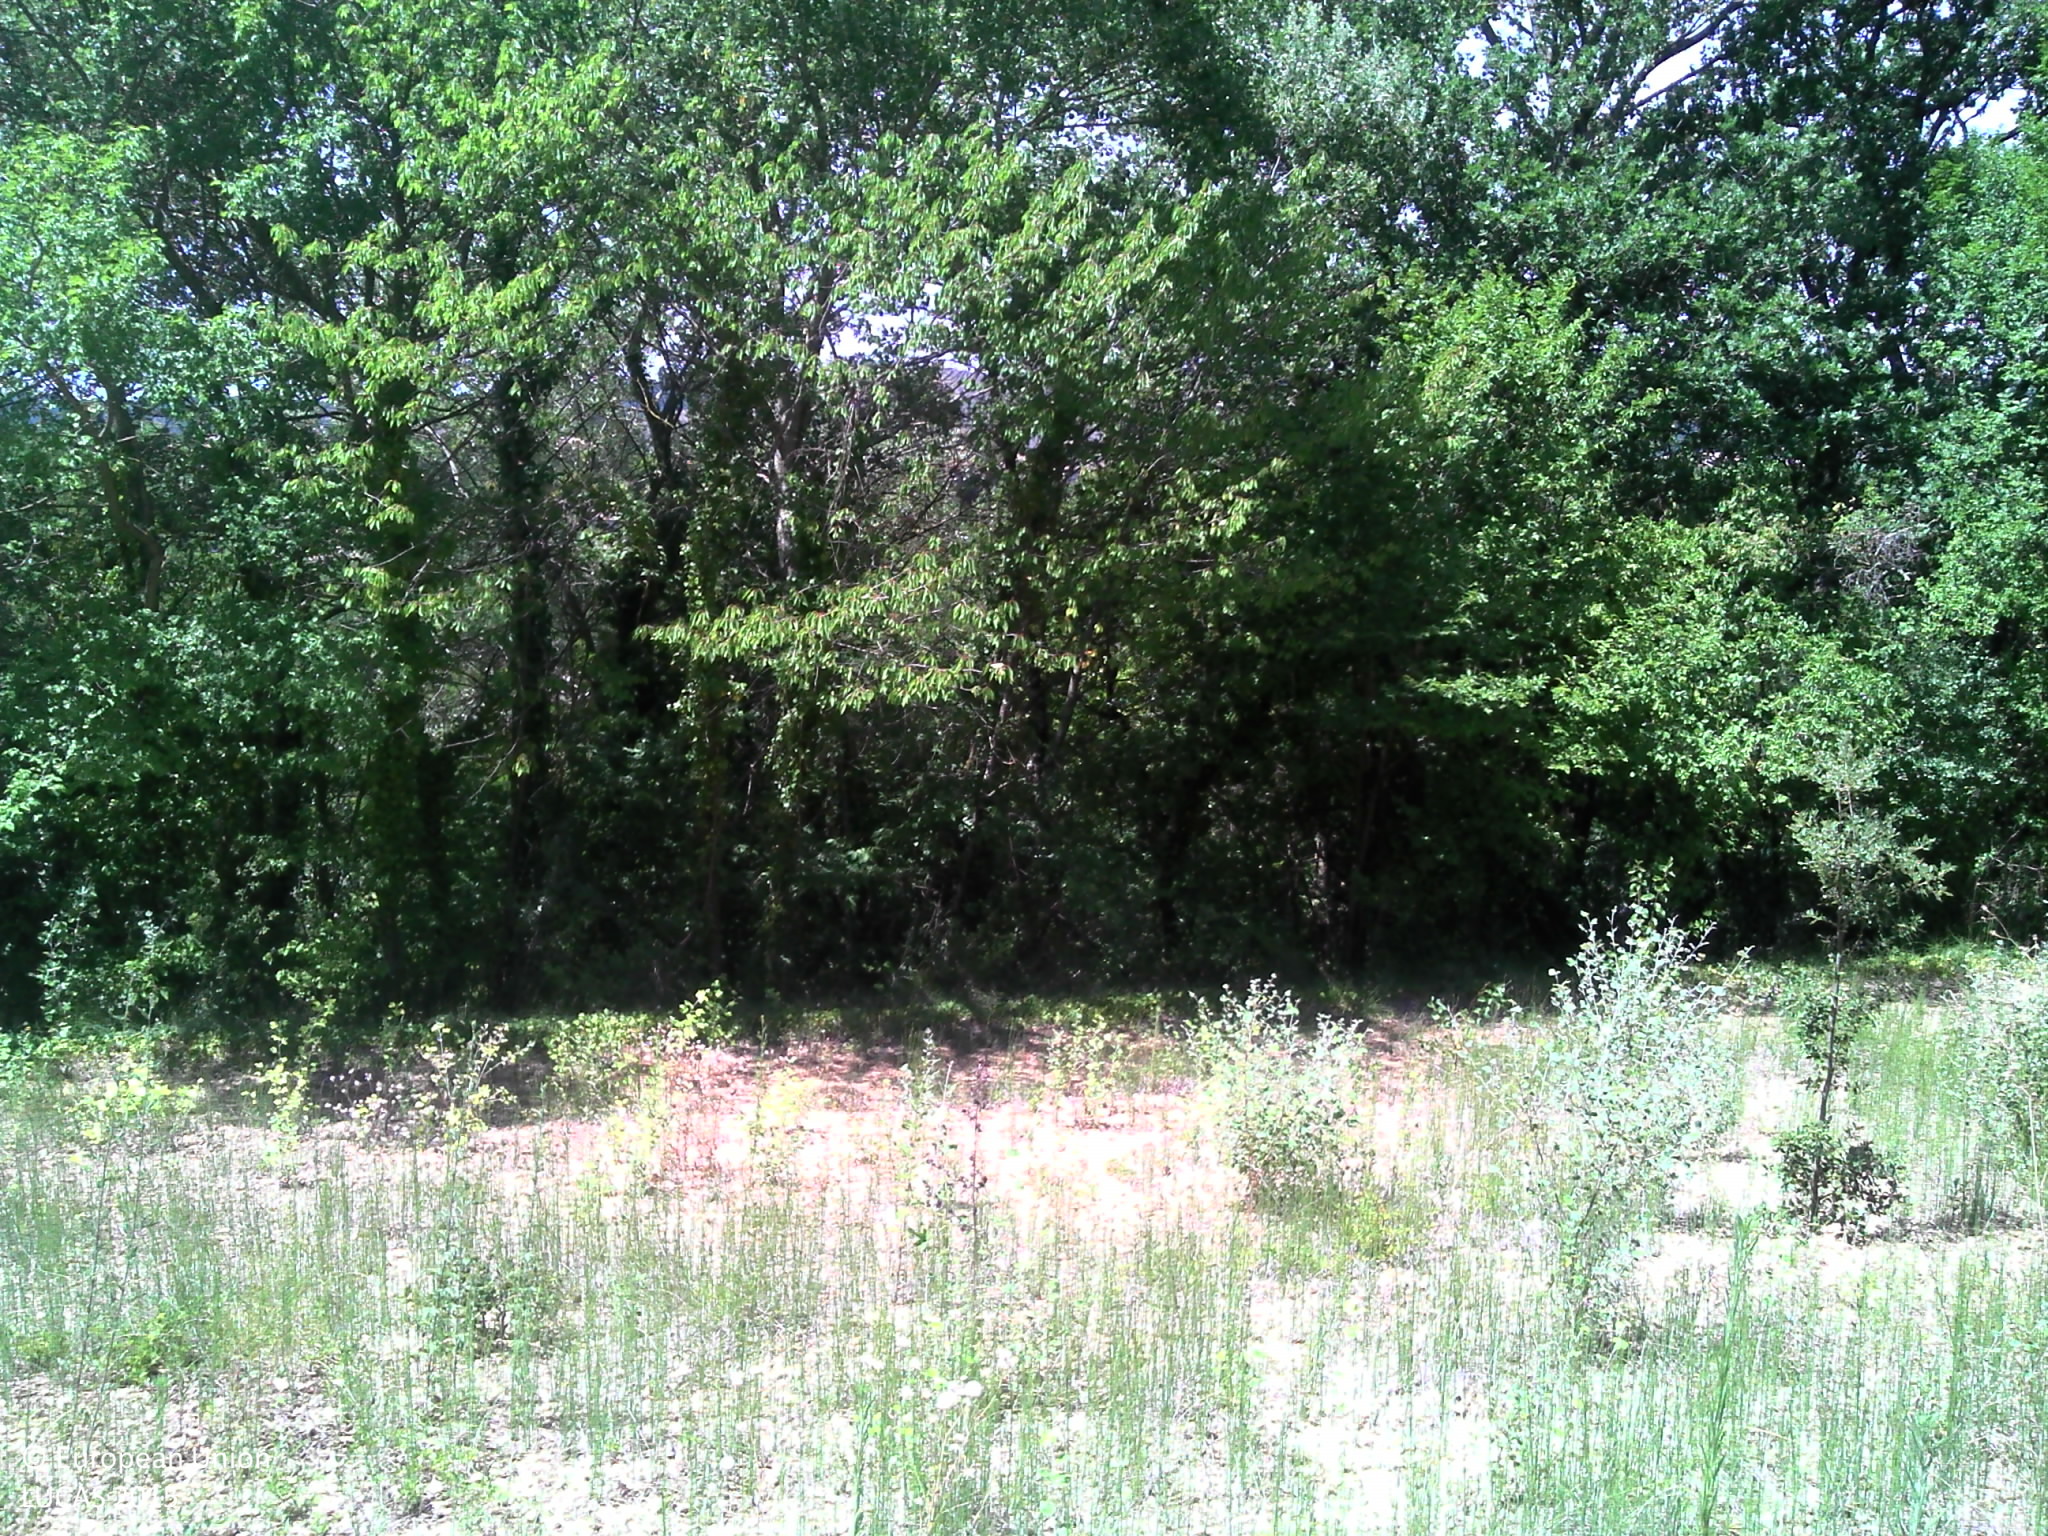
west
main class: Grassland
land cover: Spontaneously vegetated surfaces
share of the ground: 25 - 50 %
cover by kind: herbaceous plants 50 %, unconsolidated bare surface 50 %
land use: Fallow land
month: July
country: FR
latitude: 44.5536
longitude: 4.6061
